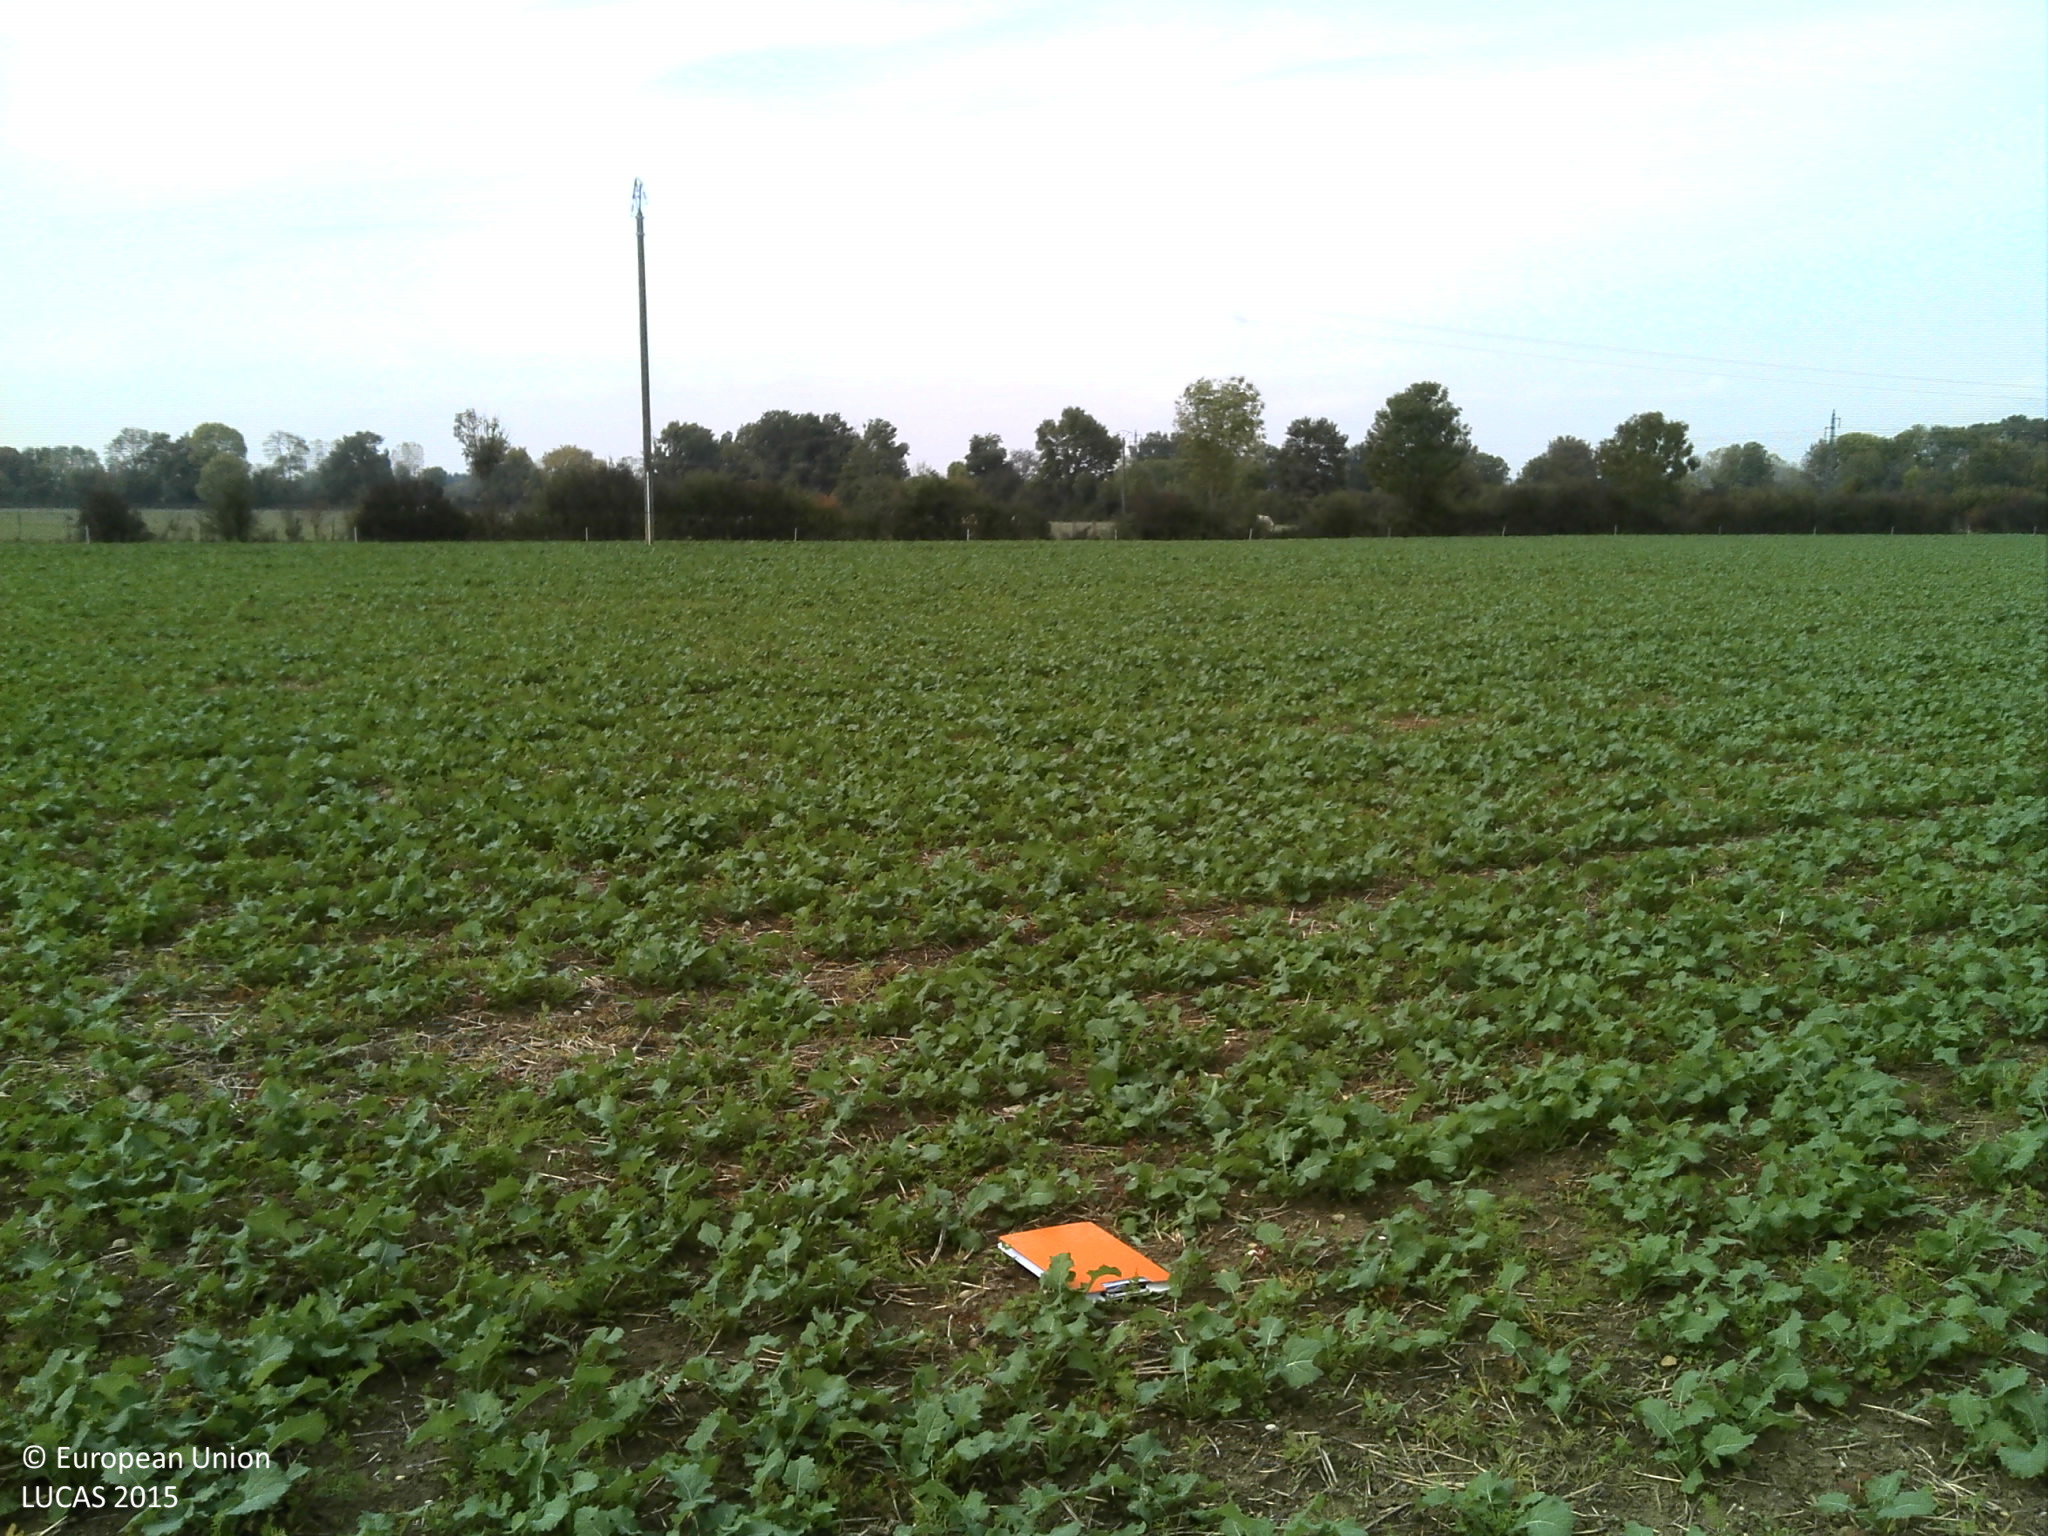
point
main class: Cropland
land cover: Rape and turnip rape
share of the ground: 50 - 75 %
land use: Agriculture (excluding fallow land and kitchen gardens)
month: October
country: FR
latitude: 46.0163
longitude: 5.3666
